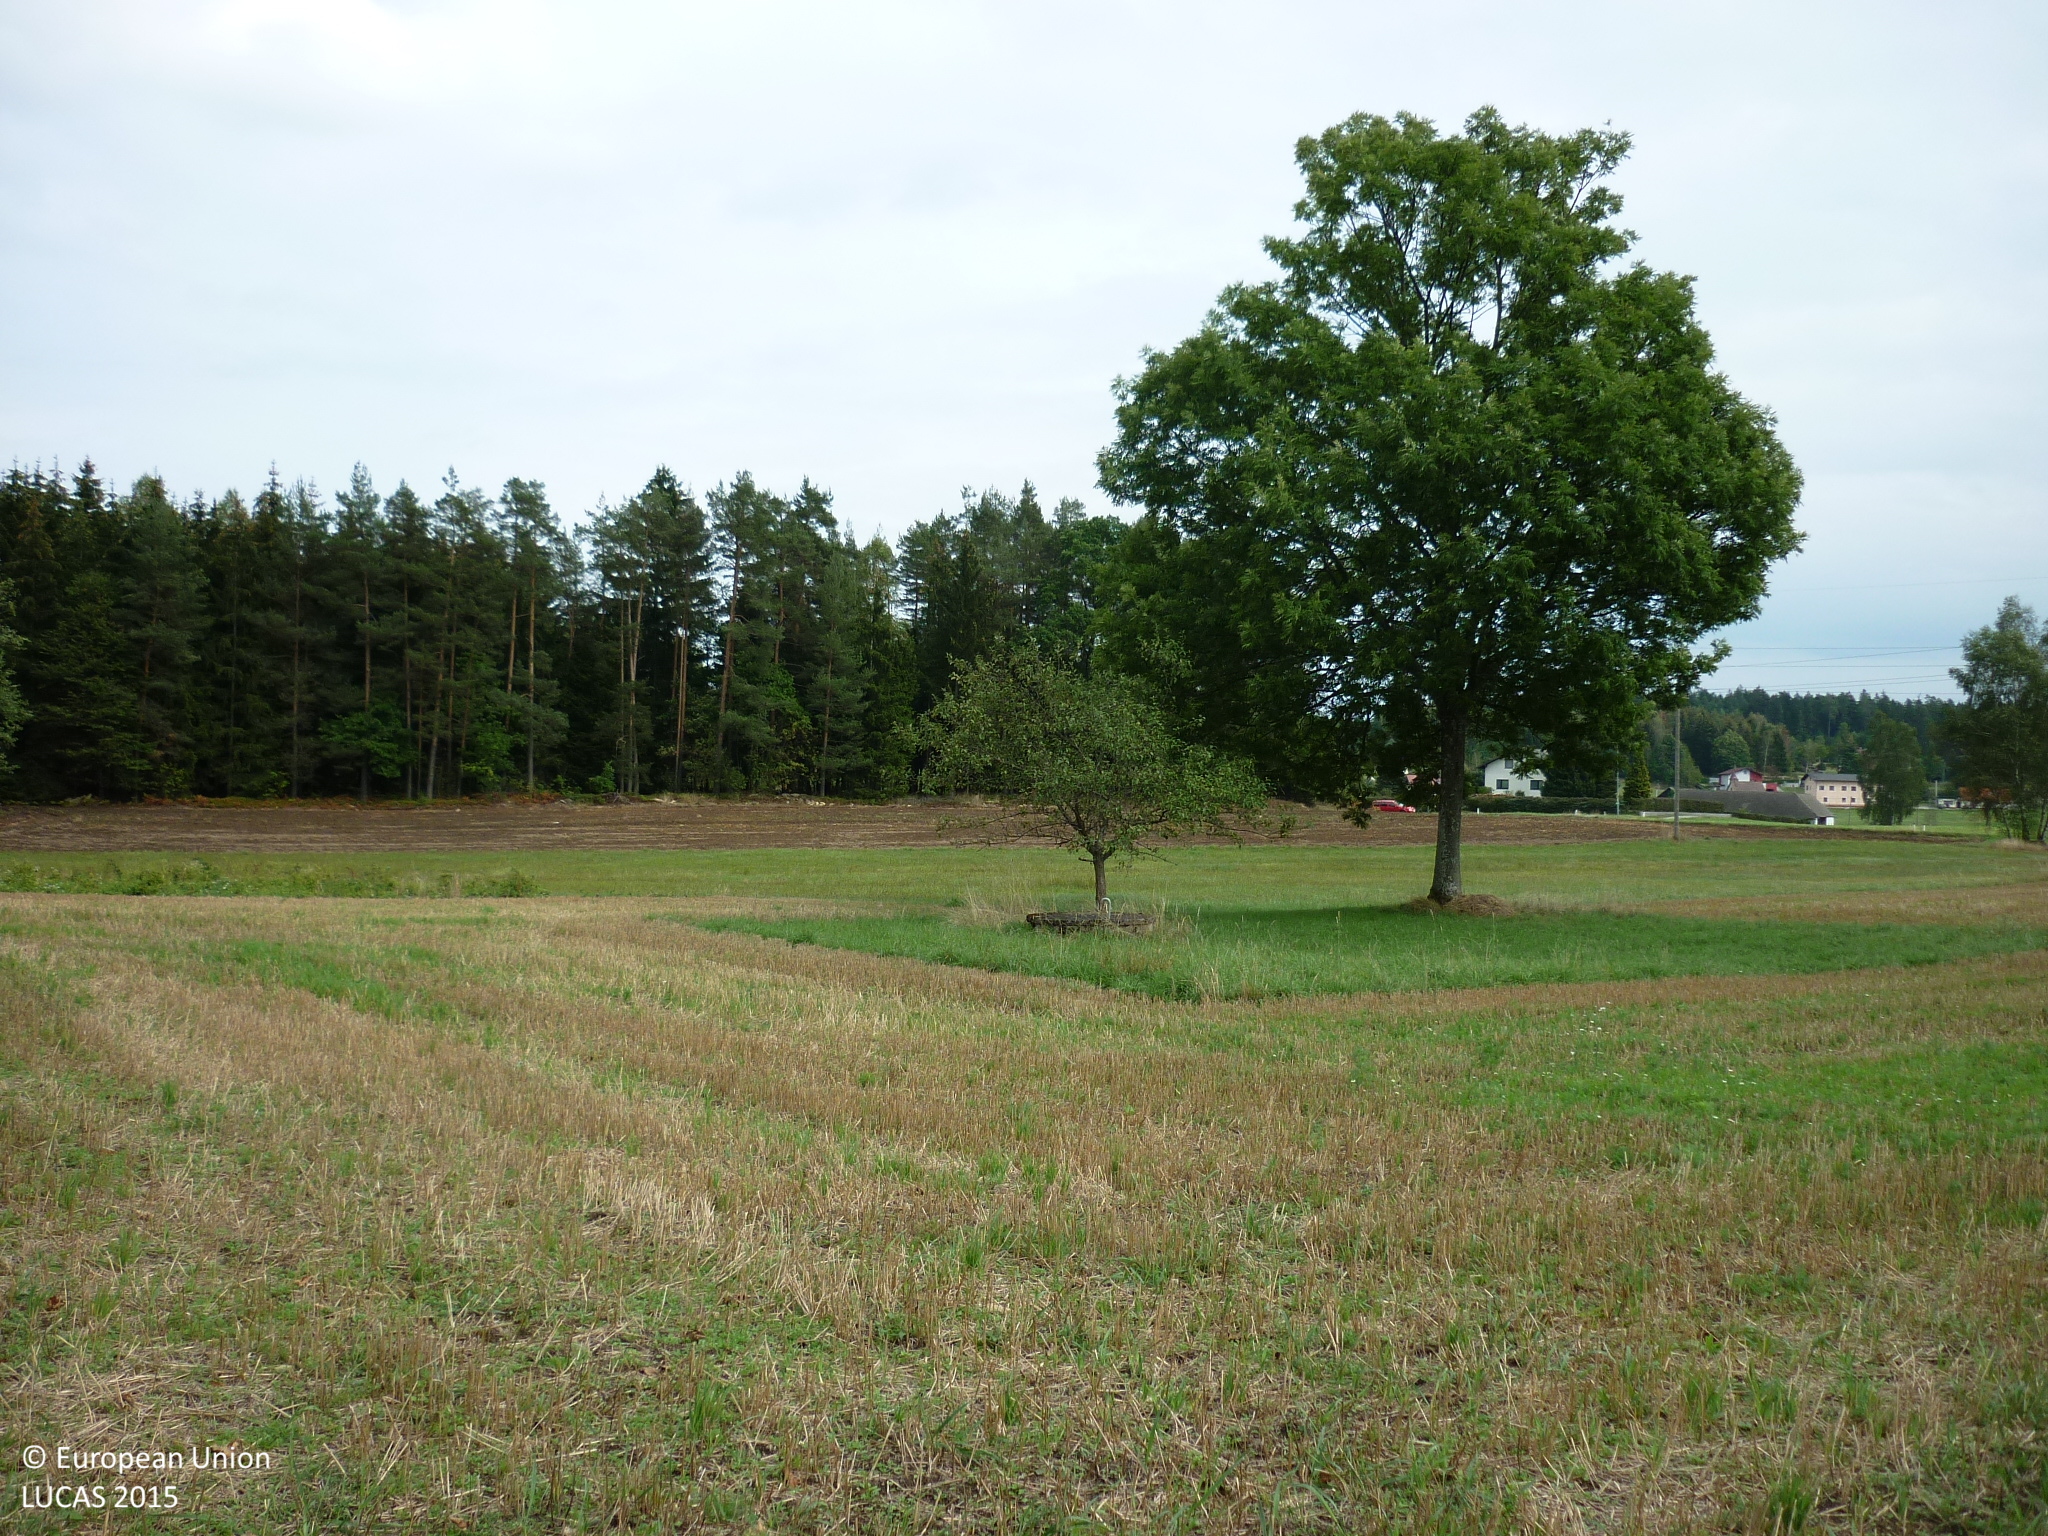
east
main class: Grassland
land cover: Spontaneously vegetated surfaces
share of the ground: 50 - 75 %
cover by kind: herbaceous plants 65 %, unconsolidated bare surface 35 %
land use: Agriculture (excluding fallow land and kitchen gardens)
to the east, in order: Tracks; Spontaneously vegetated surfaces; Grassland without tree/shrub cover; Single bushes/trees; Grassland without tree/shrub cover; Ditches and canals; Grassland without tree/shrub cover; Other leguminous and mixtures for fodder; Pine dominated mixed woodland; Grassland without tree/shrub cover; Paved roads, cycling and walking lanes; Grass margins; Electric lines; Other cereals
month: September
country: AT
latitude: 48.8454
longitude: 15.0849
